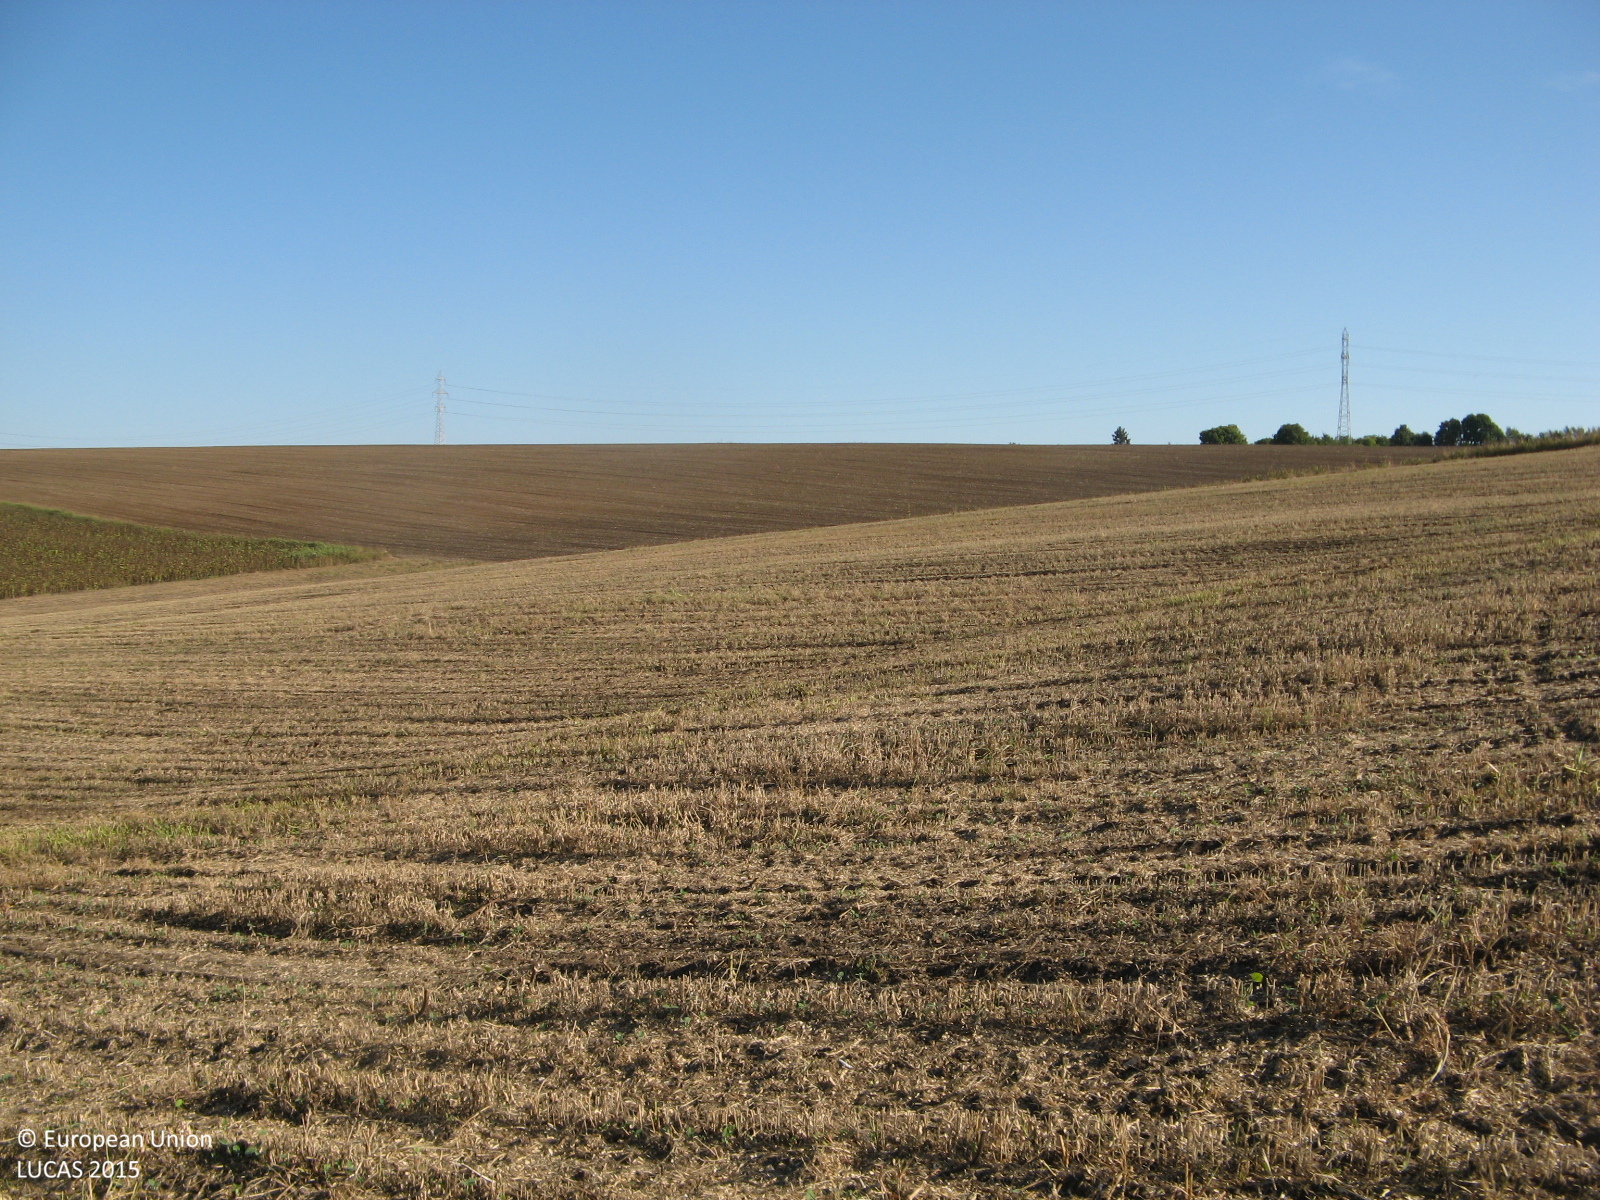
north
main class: Cropland
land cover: Soya
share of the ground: 10 - 25 %
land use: Agriculture (excluding fallow land and kitchen gardens)
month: September
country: BG
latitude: 43.7400
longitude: 26.1284
